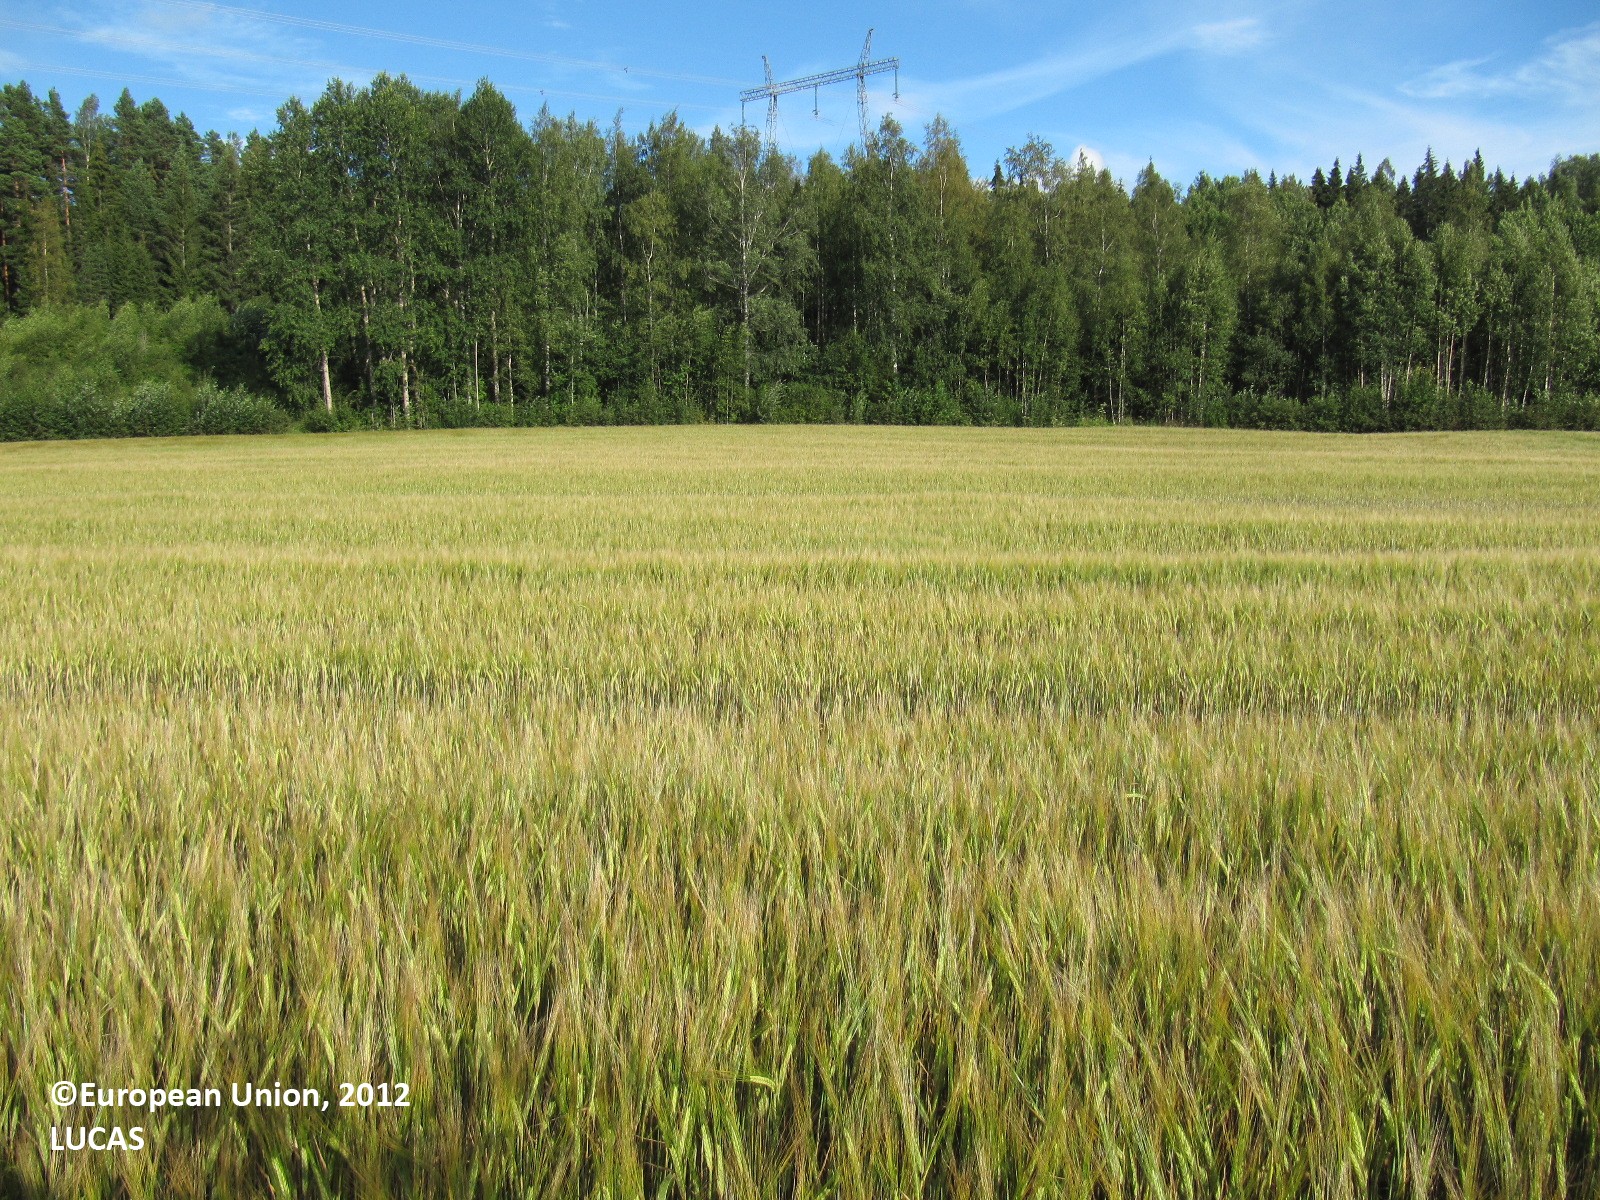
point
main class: Cropland
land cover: Barley
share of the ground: > 75 %
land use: Agriculture (excluding fallow land and kitchen gardens)
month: August
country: FI
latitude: 60.3097
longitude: 23.1681
